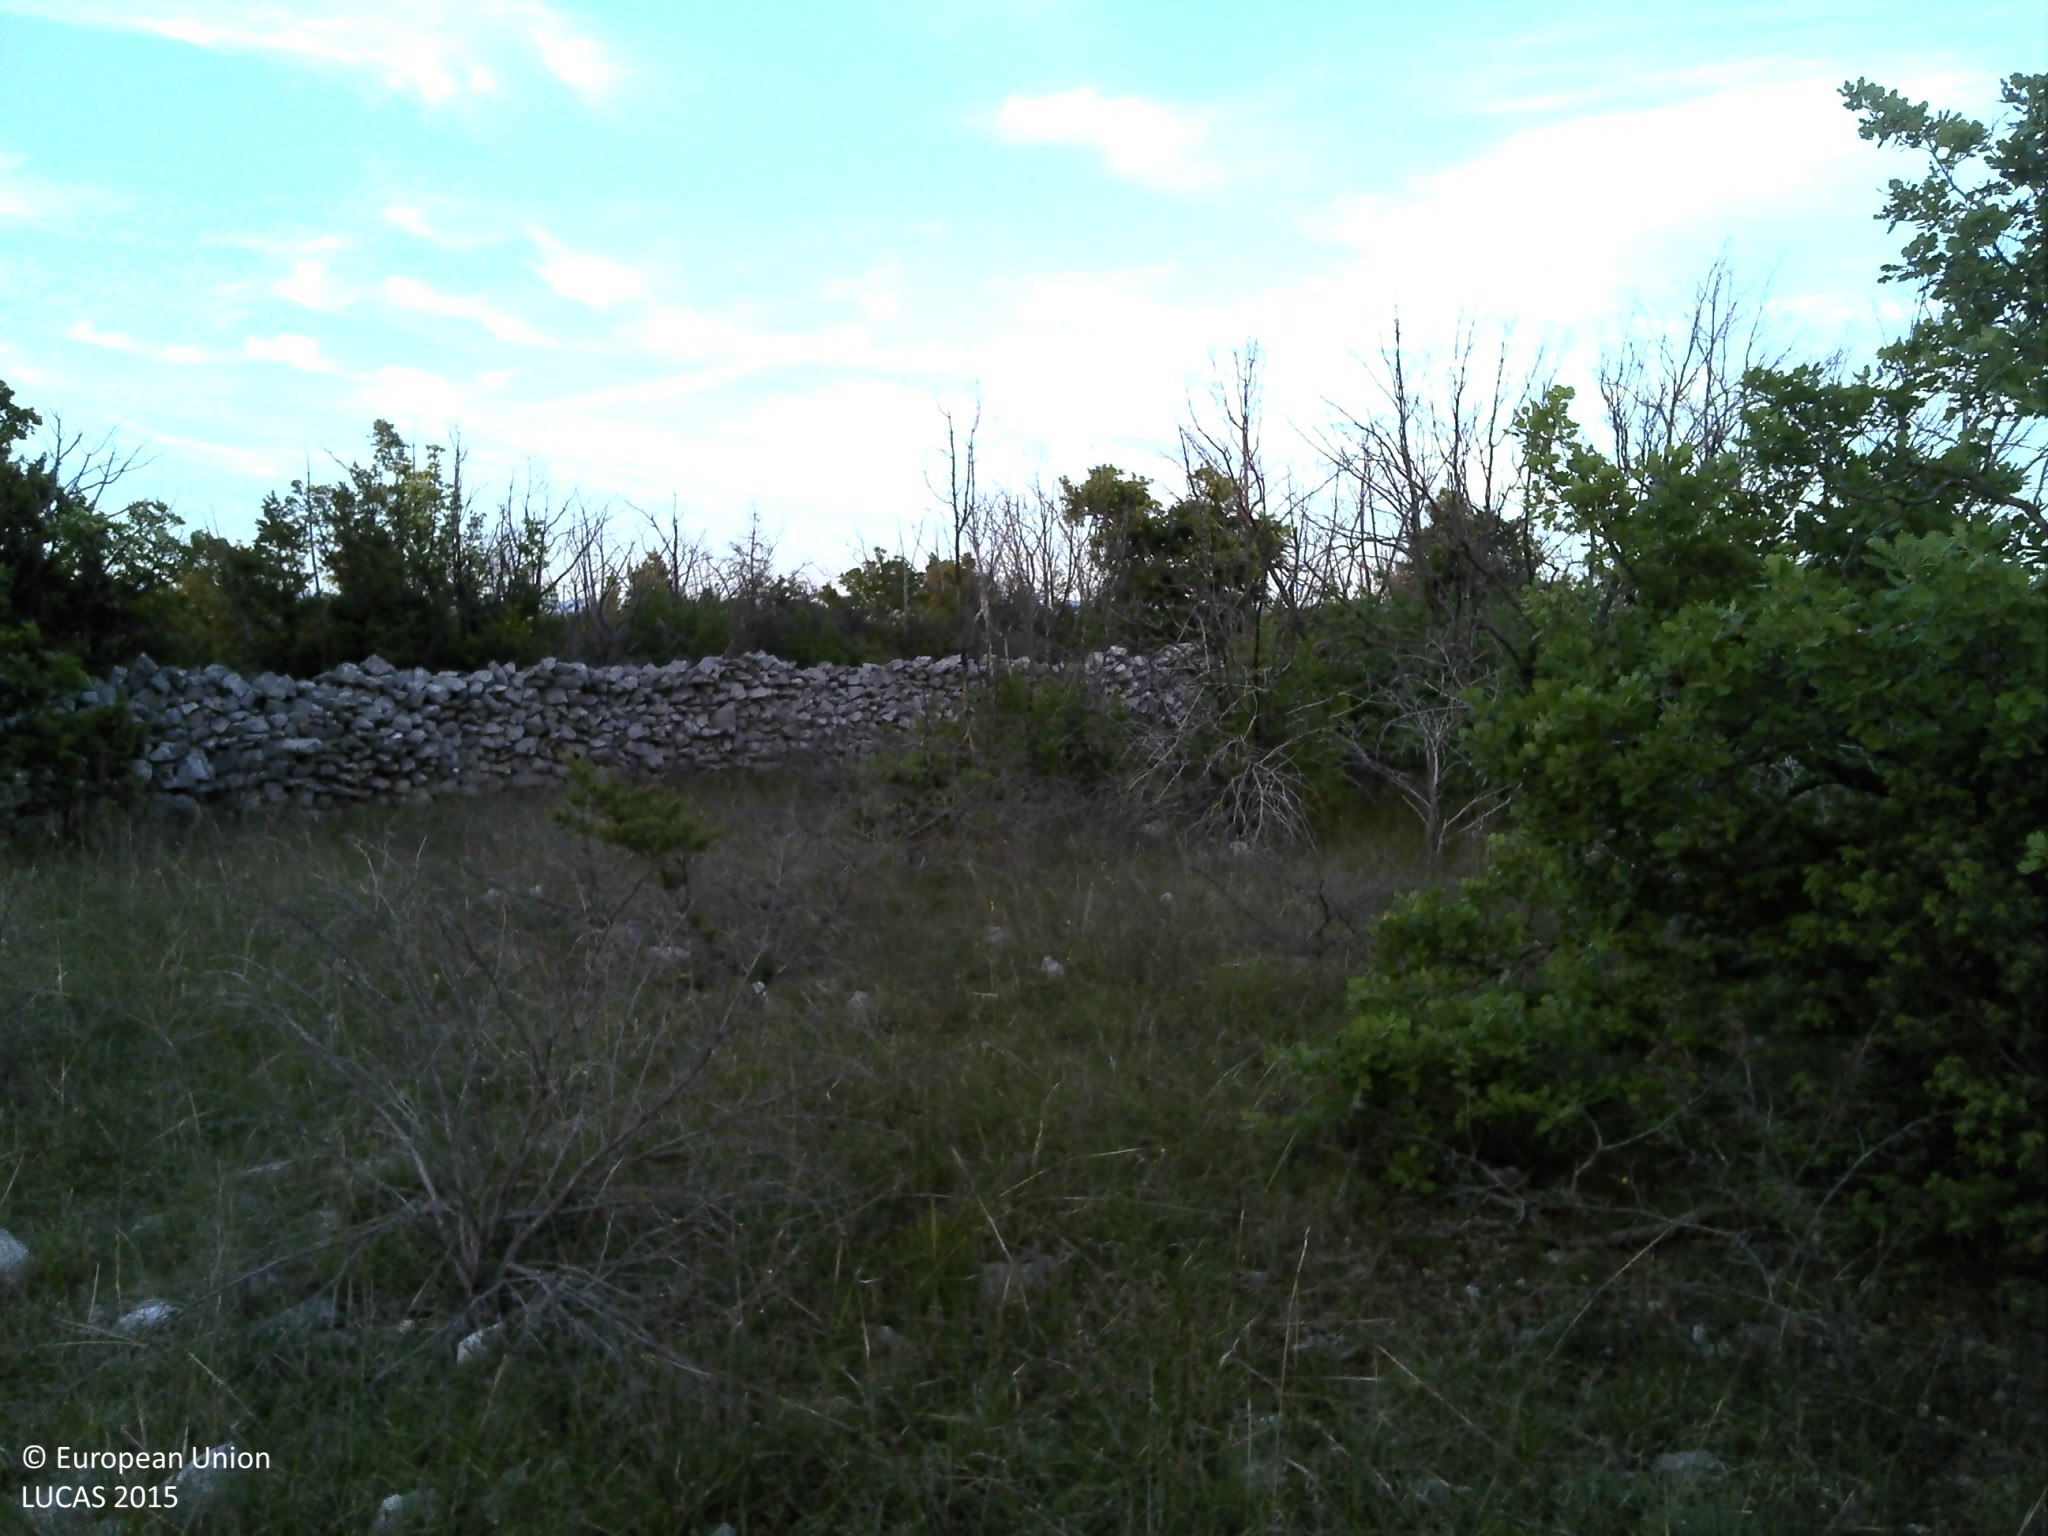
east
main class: Shrubland
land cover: Shrubland without tree cover
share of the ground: 25 - 50 %
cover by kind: herbaceous plants 45 %, shrubs 25 %, unconsolidated bare surface 20 %, consolidated bare surface 10 %
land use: Semi-natural and natural areas not in use
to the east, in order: Shrubland without tree cover; Dry stone walls; Shrubland with sparse tree cover; Dry stone walls; Shrubland with sparse tree cover; Dry stone walls; Shrubland with sparse tree cover; Dry stone walls; Shrubland with sparse tree cover; Dry stone walls; Shruby margins; Tracks; Shruby margins; Dry stone walls; Shrubland without tree cover; Dry stone walls; Broadleaved woodland
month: May
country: HR
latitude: 43.7795
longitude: 15.9926
